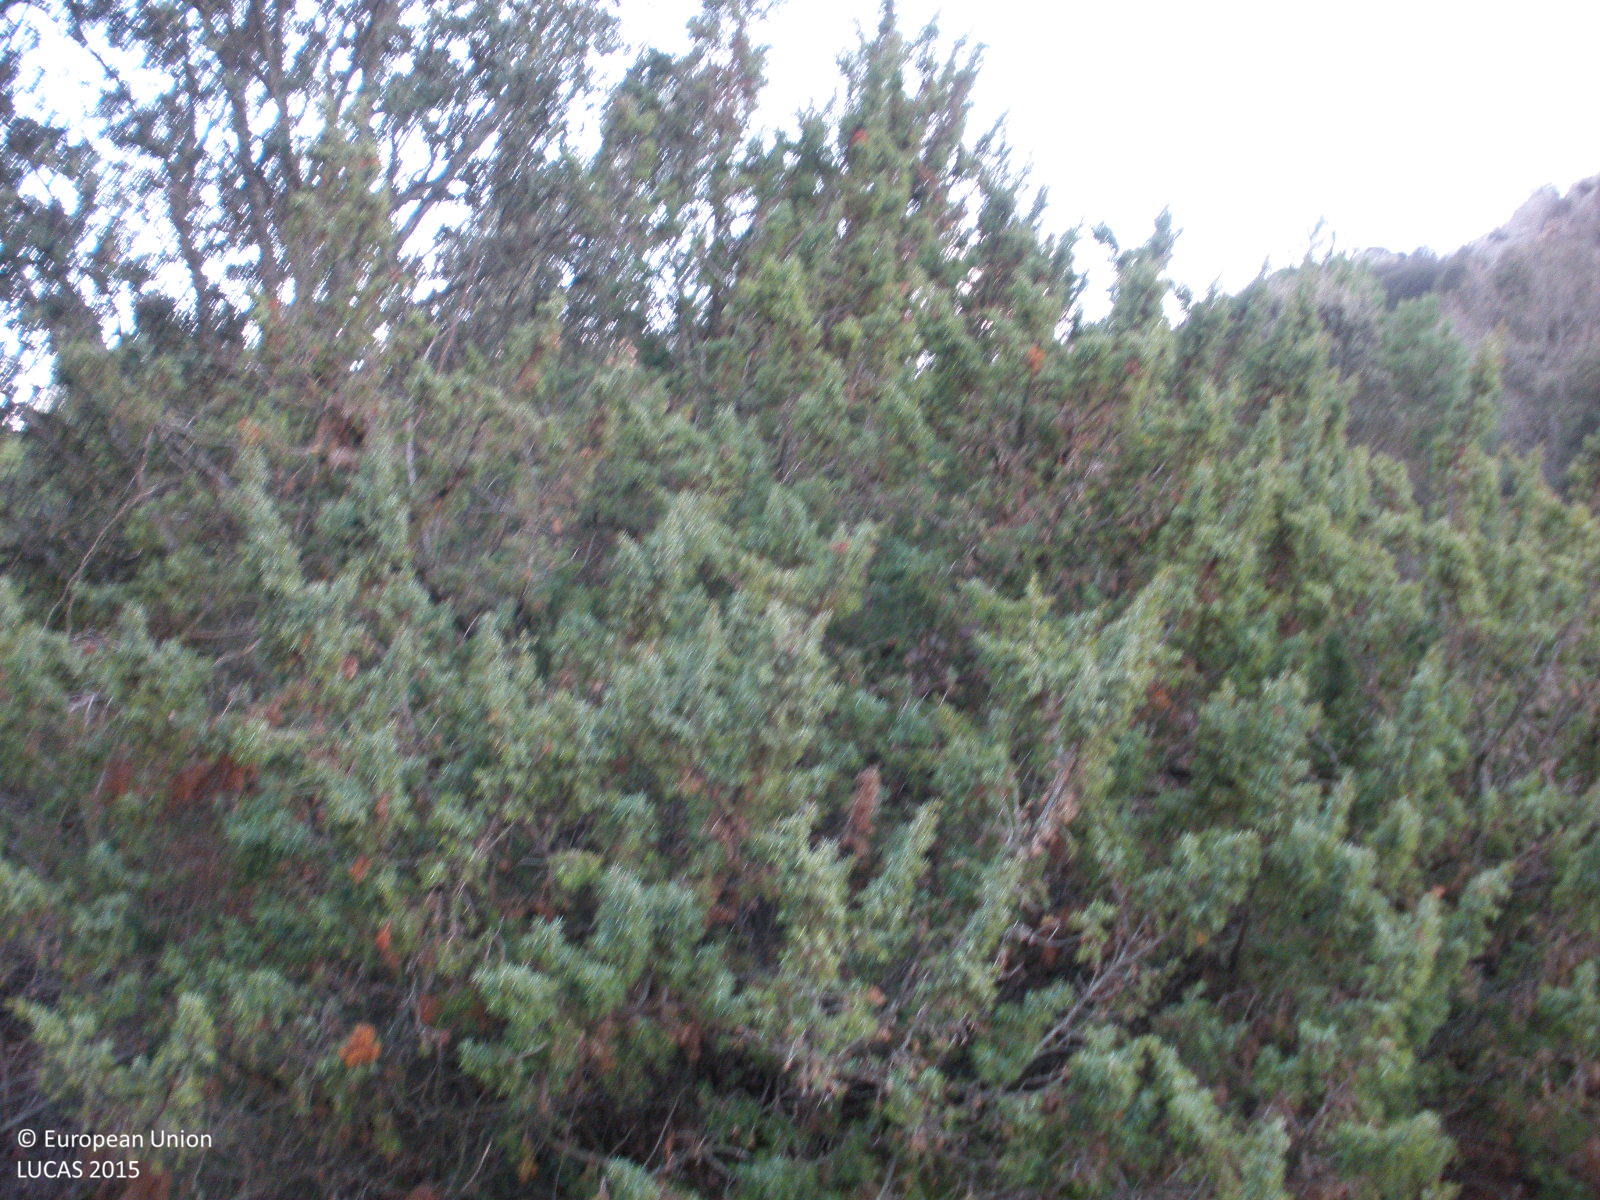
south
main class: Woodland
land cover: Other mixed woodland
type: coniferous forest of the mediterranean region
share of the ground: > 75 %
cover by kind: broadleaved forest trees 40 %, coniferous forest trees 30 %, shrubs 30 %
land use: Semi-natural and natural areas not in use
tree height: < 5 m
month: April
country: ES
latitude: 41.1042
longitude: -1.1759
